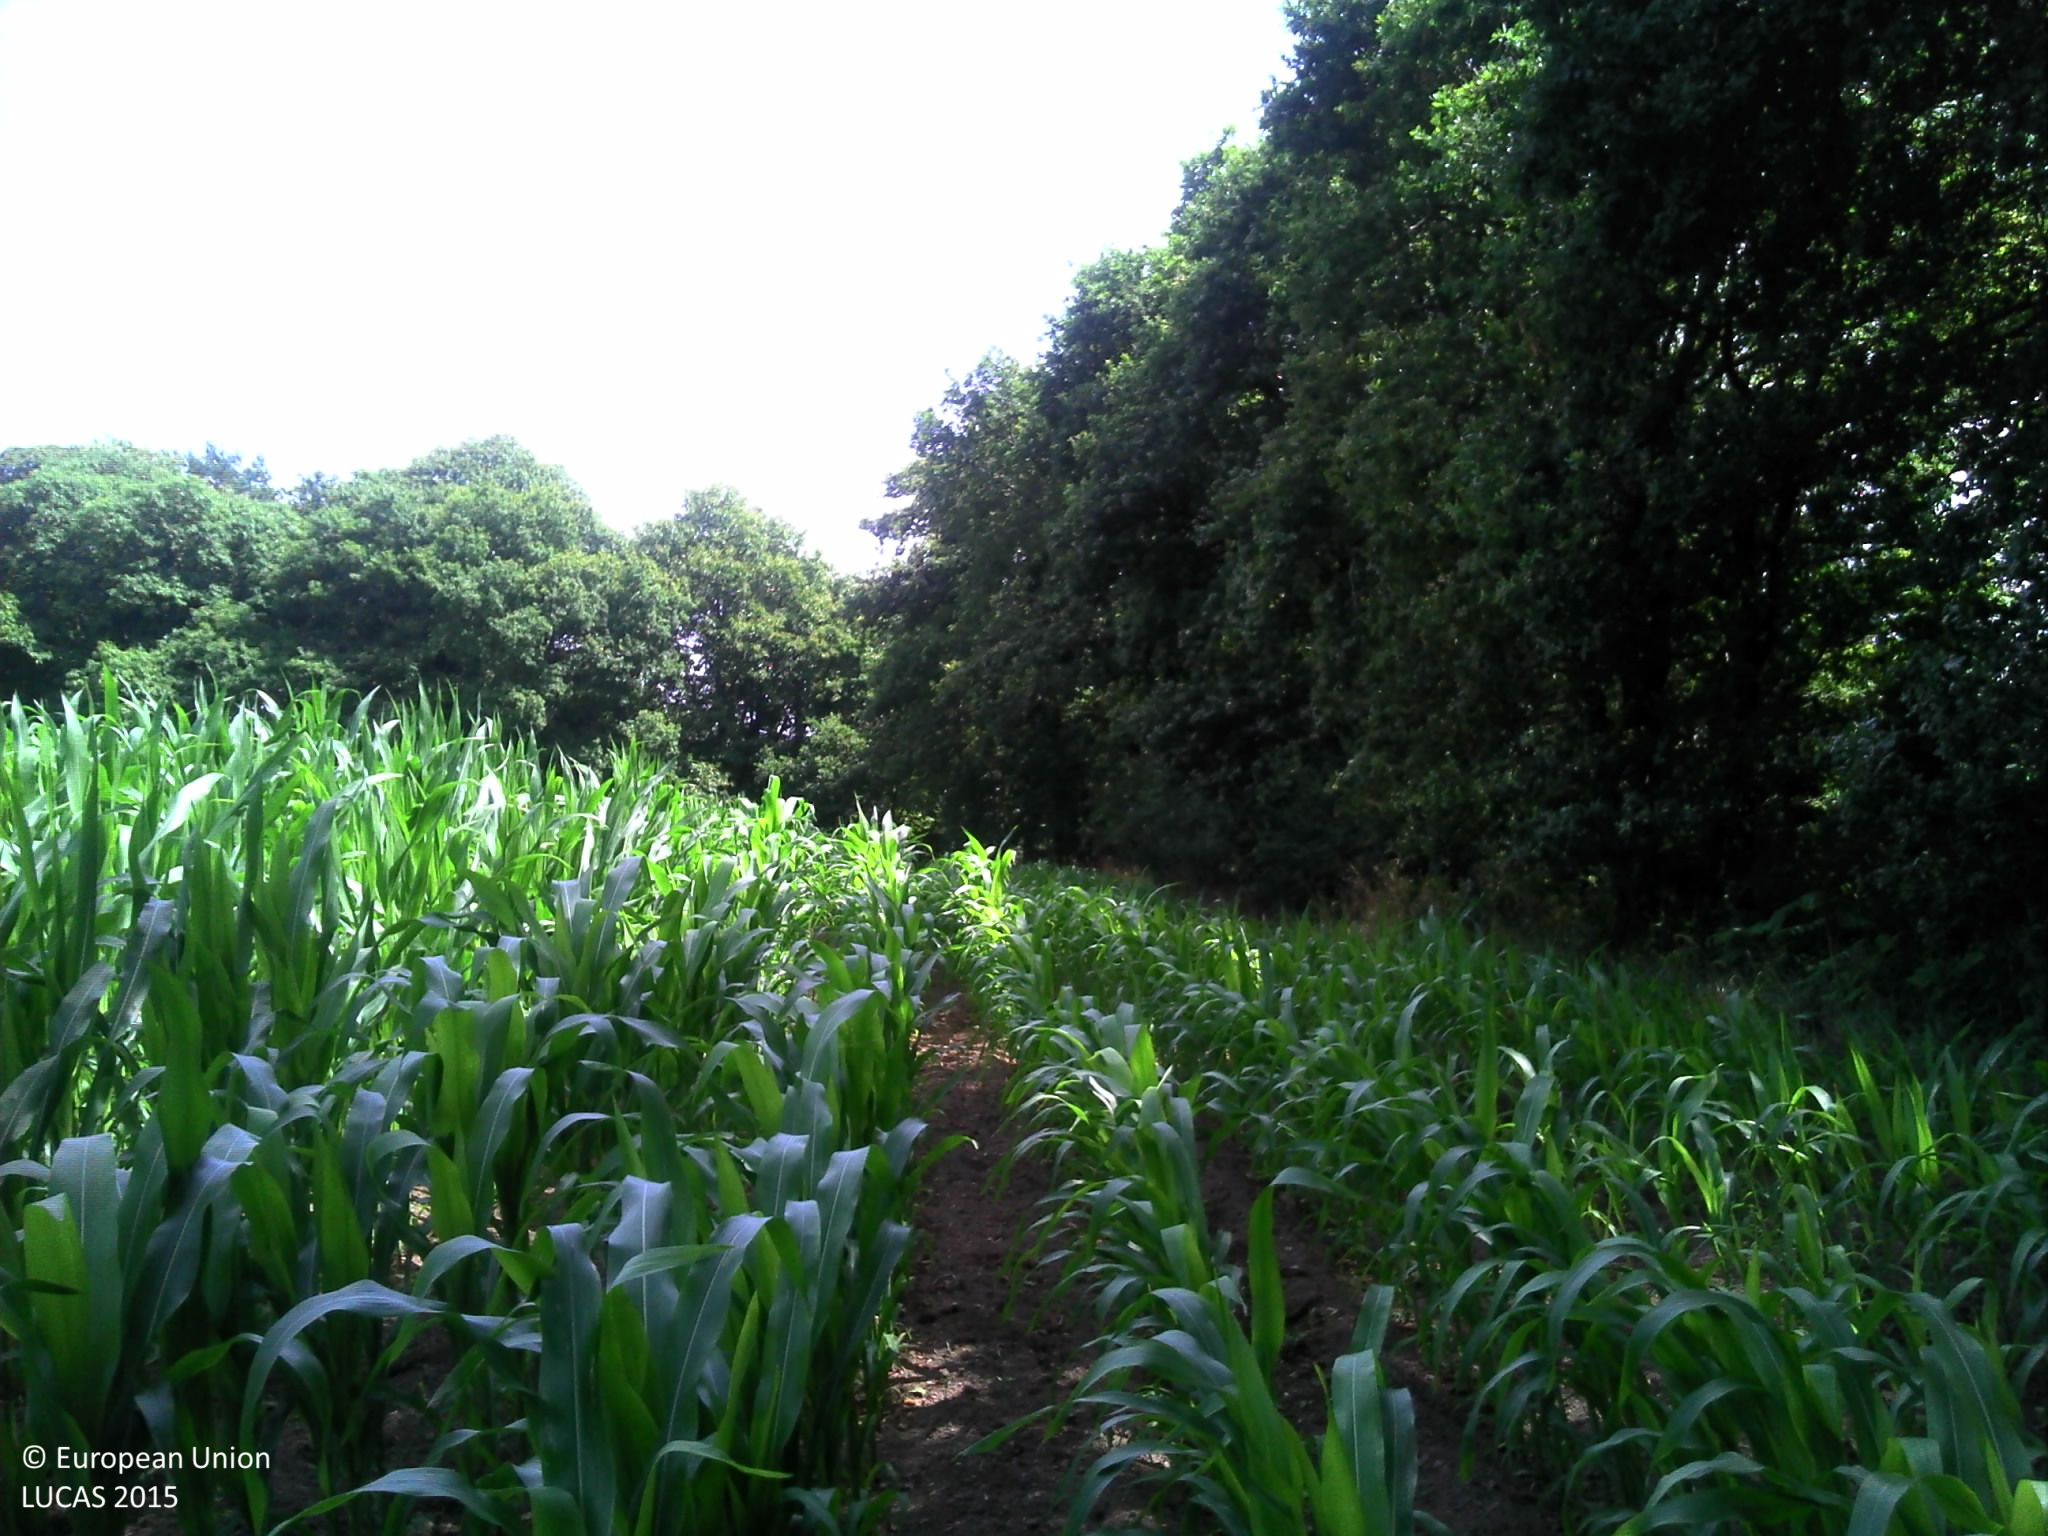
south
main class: Cropland
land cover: Maize
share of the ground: > 75 %
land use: Agriculture (excluding fallow land and kitchen gardens)
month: July
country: FR
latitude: 48.0255
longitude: -3.0624
